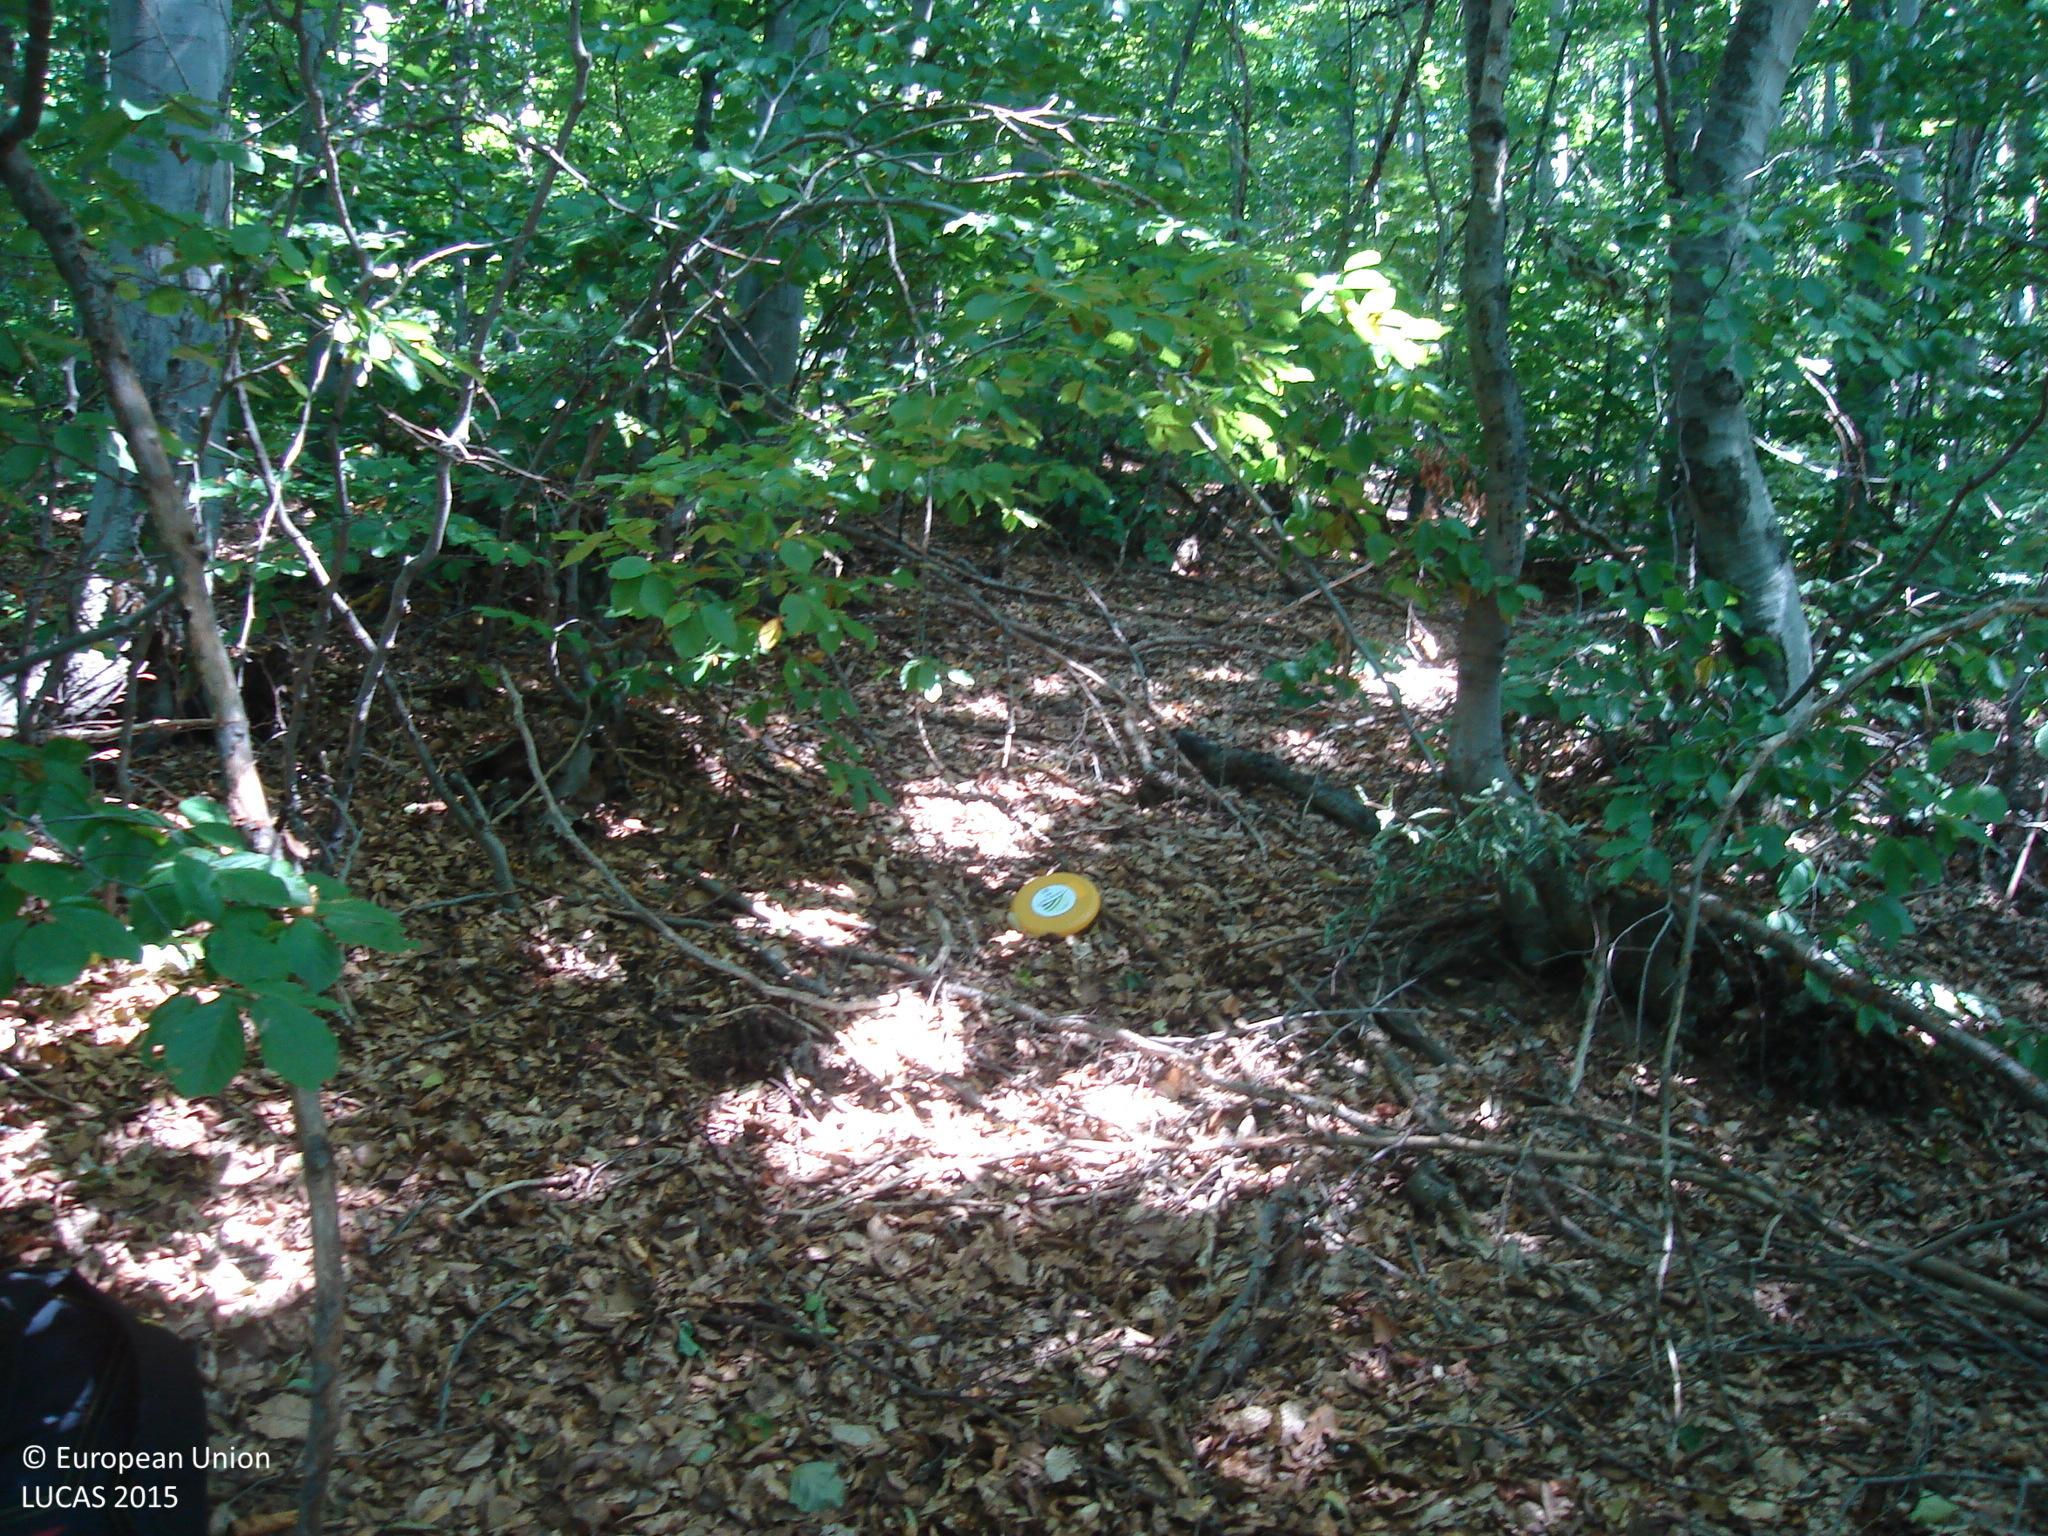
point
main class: Woodland
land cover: Broadleaved woodland
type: beech forest
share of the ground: > 75 %
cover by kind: broadleaved forest trees 100 %
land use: Forestry
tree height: > 5 m
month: September
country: BG
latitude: 42.5264
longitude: 23.8082
